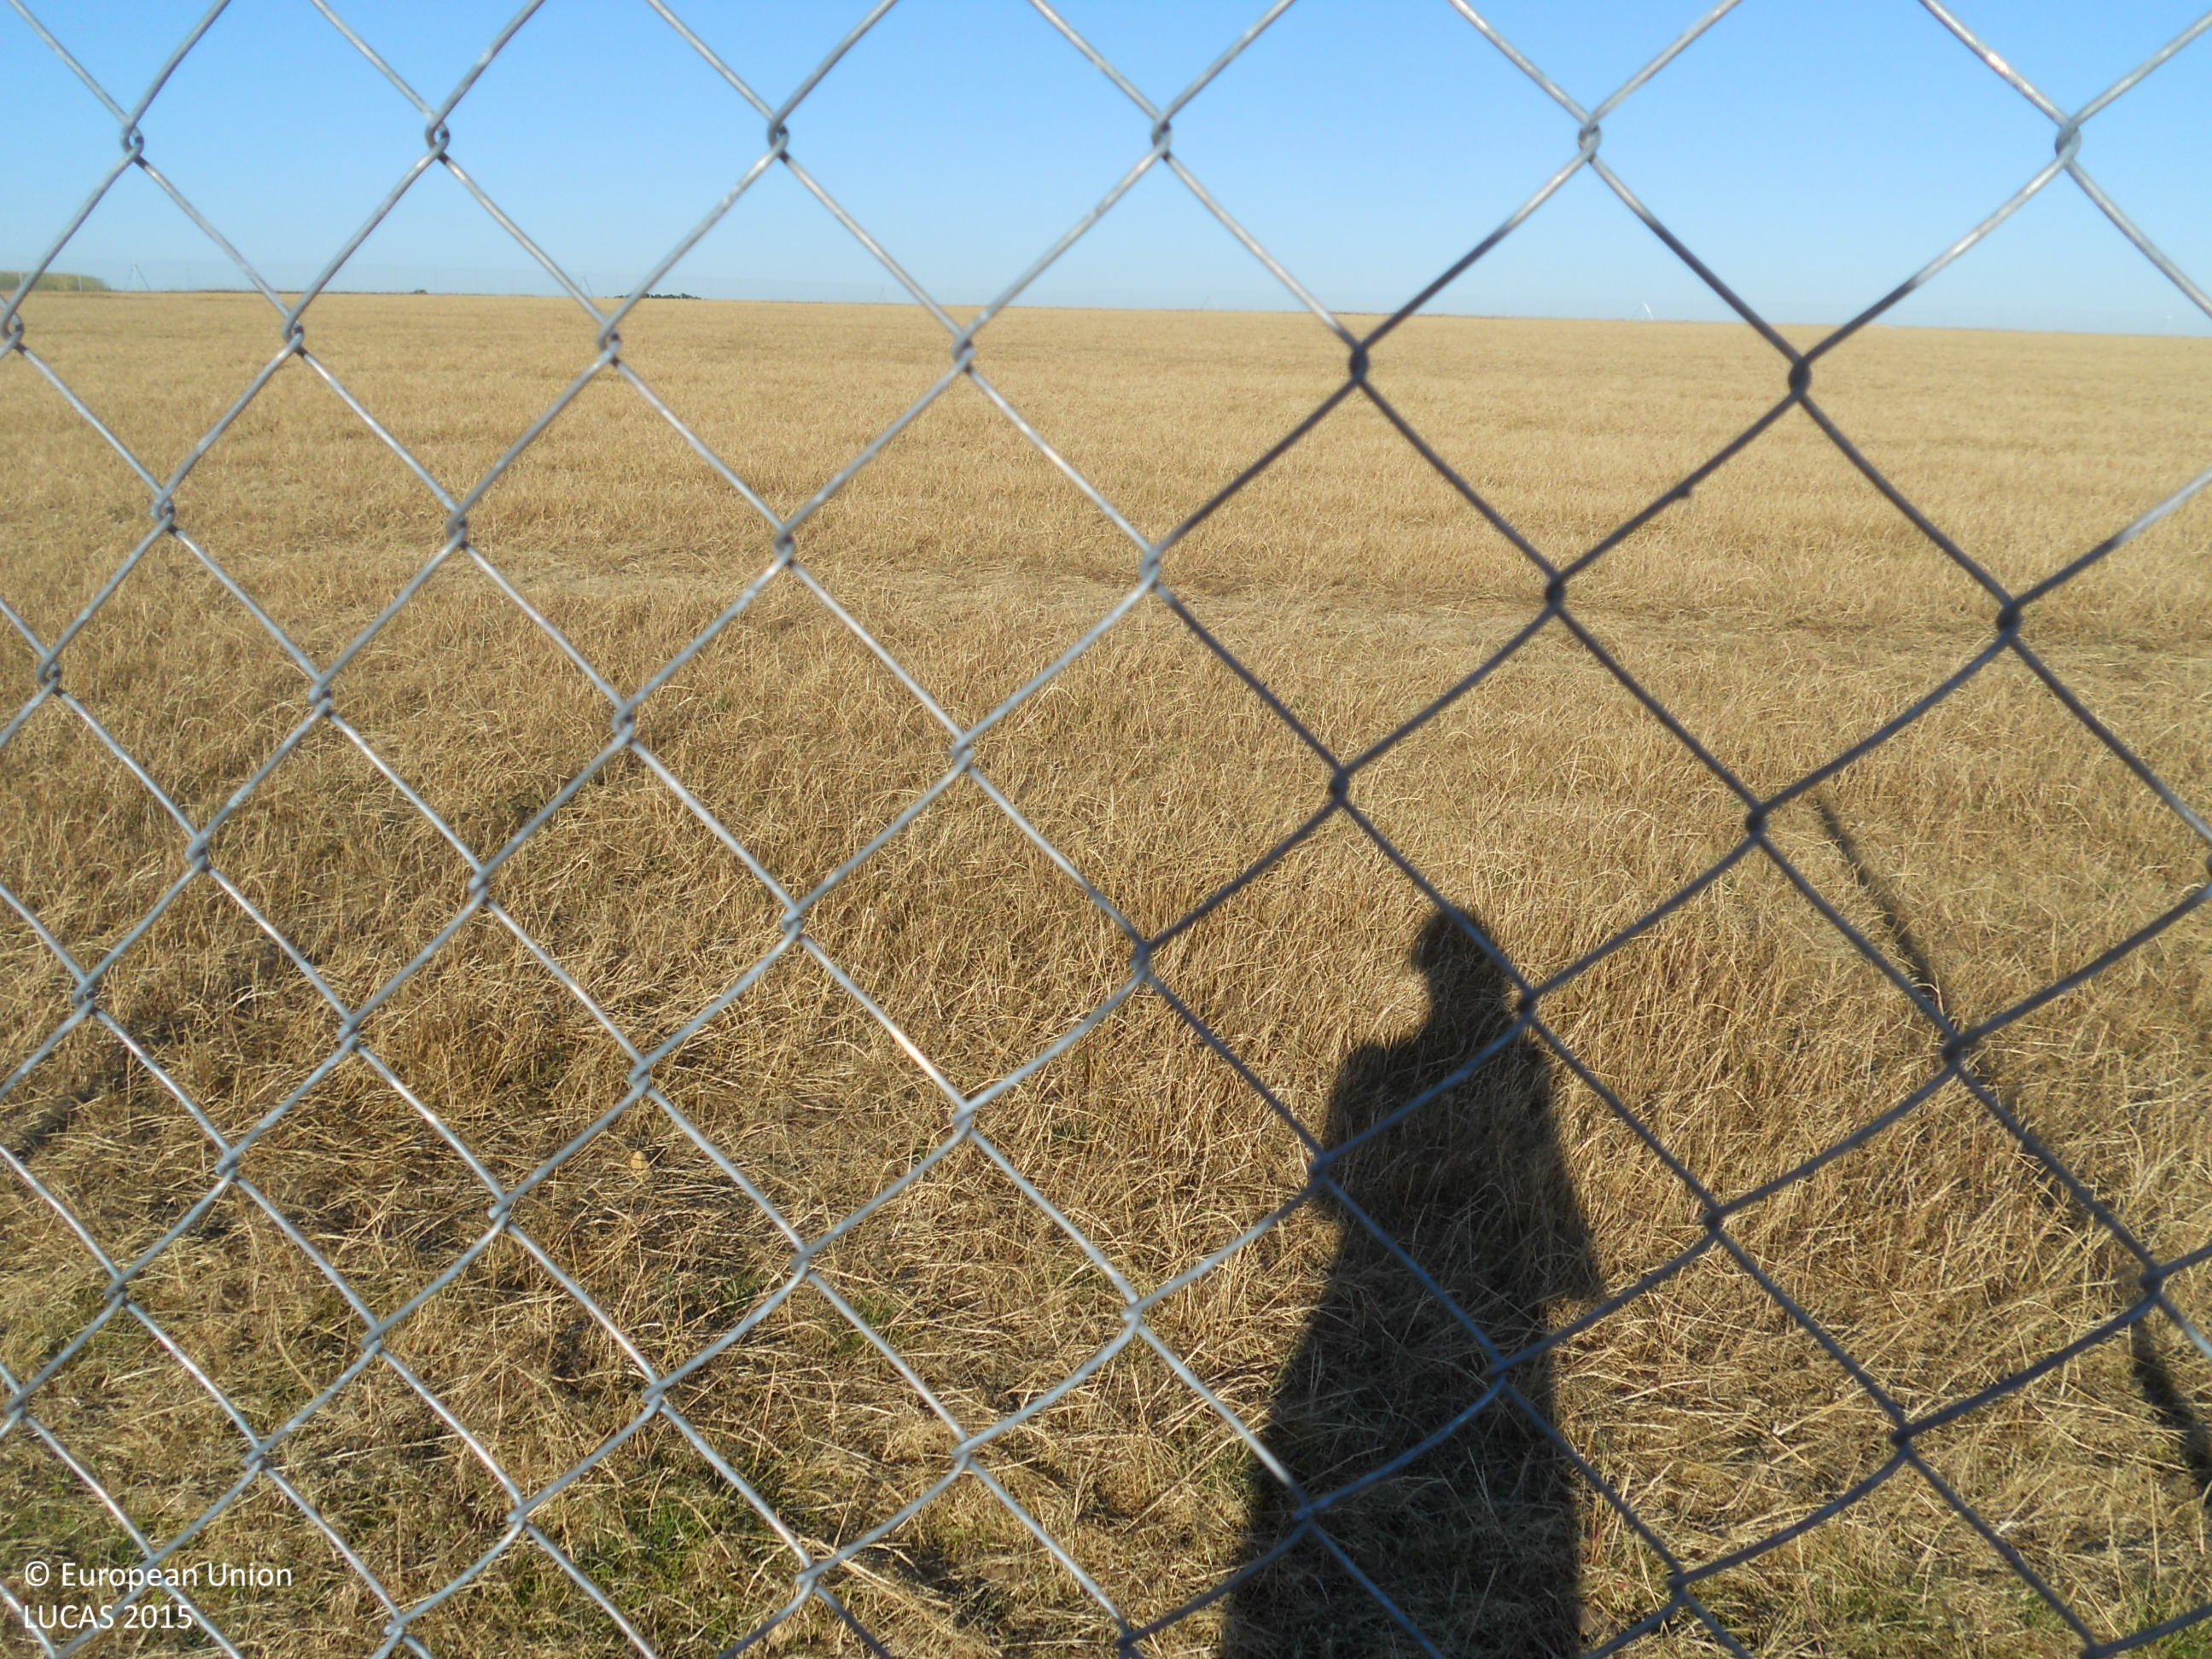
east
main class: Grassland
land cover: Spontaneously vegetated surfaces
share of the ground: > 75 %
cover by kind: herbaceous plants 100 %
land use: Fallow land
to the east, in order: Spontaneously vegetated surfaces; Fences; Spontaneously vegetated surfaces; Fences; Grassland without tree/shrub cover
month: June
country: ES
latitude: 42.5594
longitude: -4.8570
